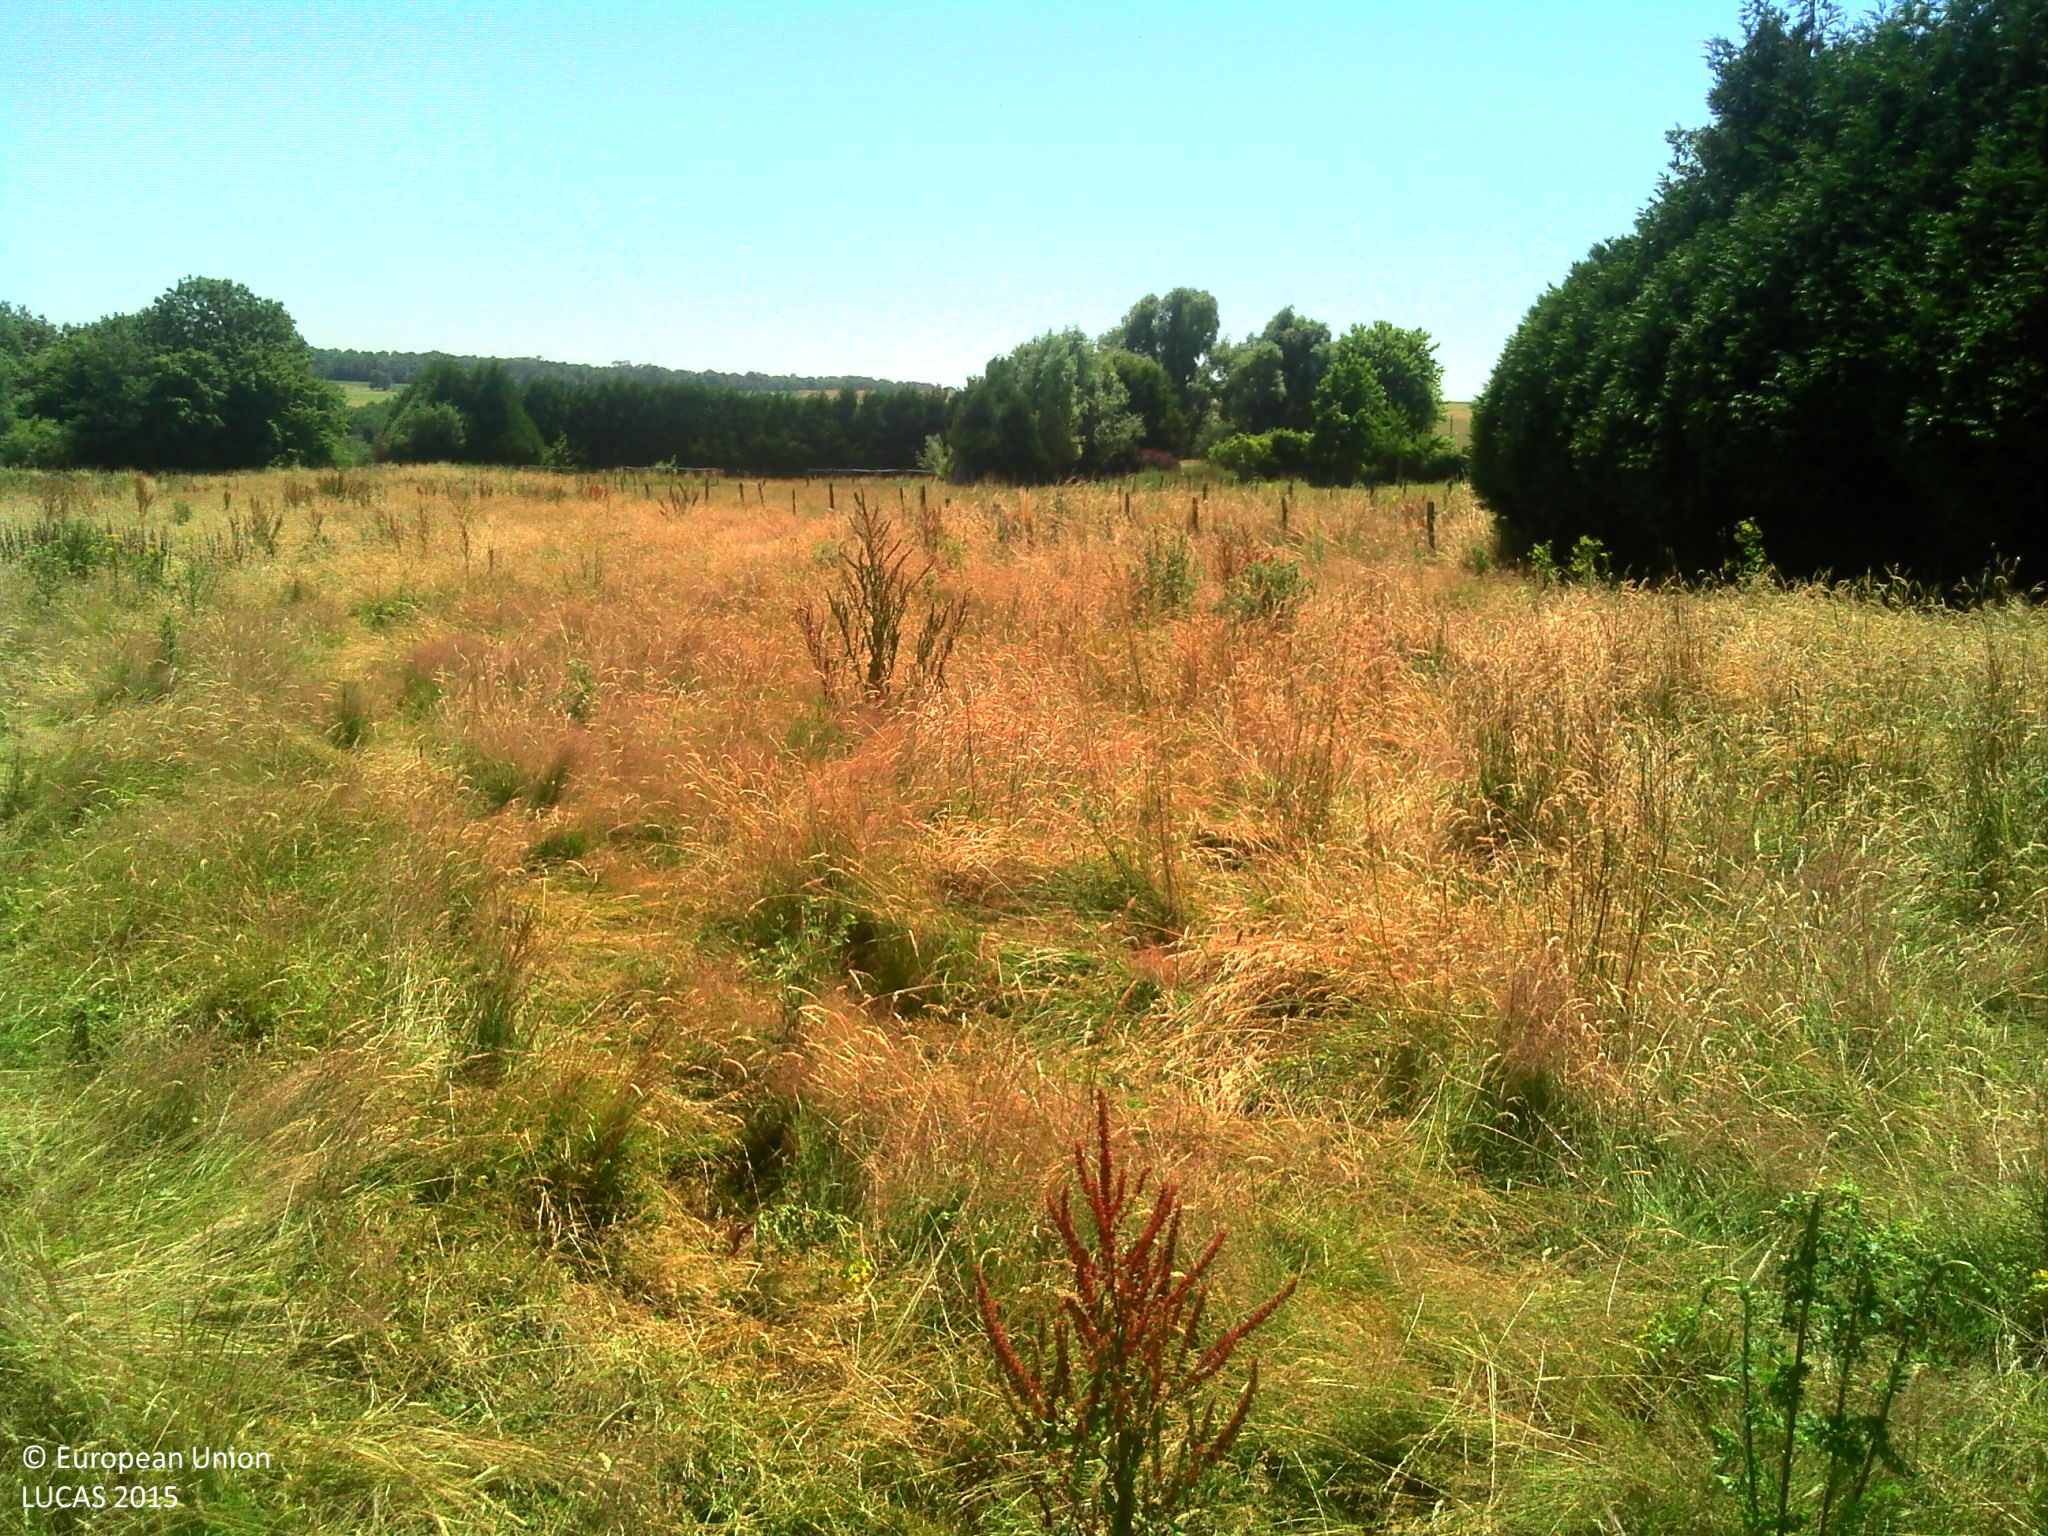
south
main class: Grassland
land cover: Grassland without tree/shrub cover
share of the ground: > 75 %
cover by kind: herbaceous plants 100 %
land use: Agriculture (excluding fallow land and kitchen gardens)
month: June
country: FR
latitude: 48.9413
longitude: 3.3164
